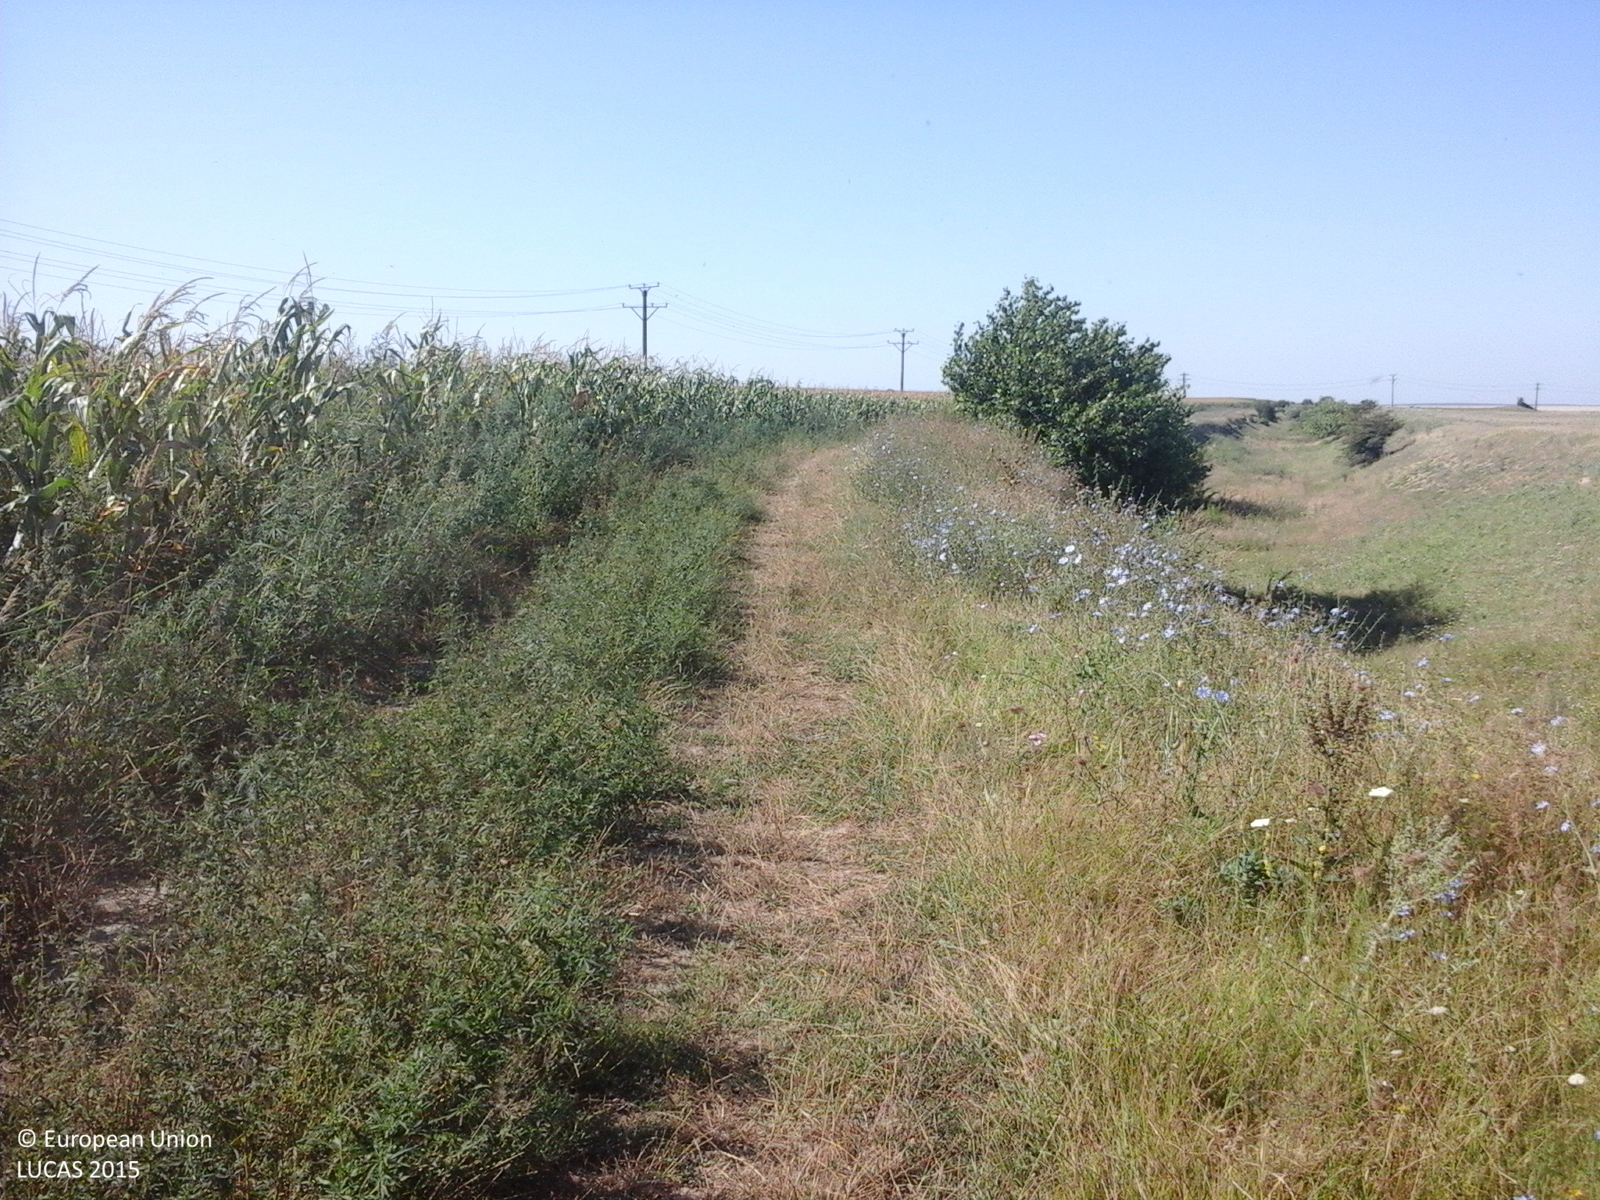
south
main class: Cropland
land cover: Maize
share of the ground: > 75 %
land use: Agriculture (excluding fallow land and kitchen gardens)
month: August
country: RO
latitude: 44.6595
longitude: 28.2133
